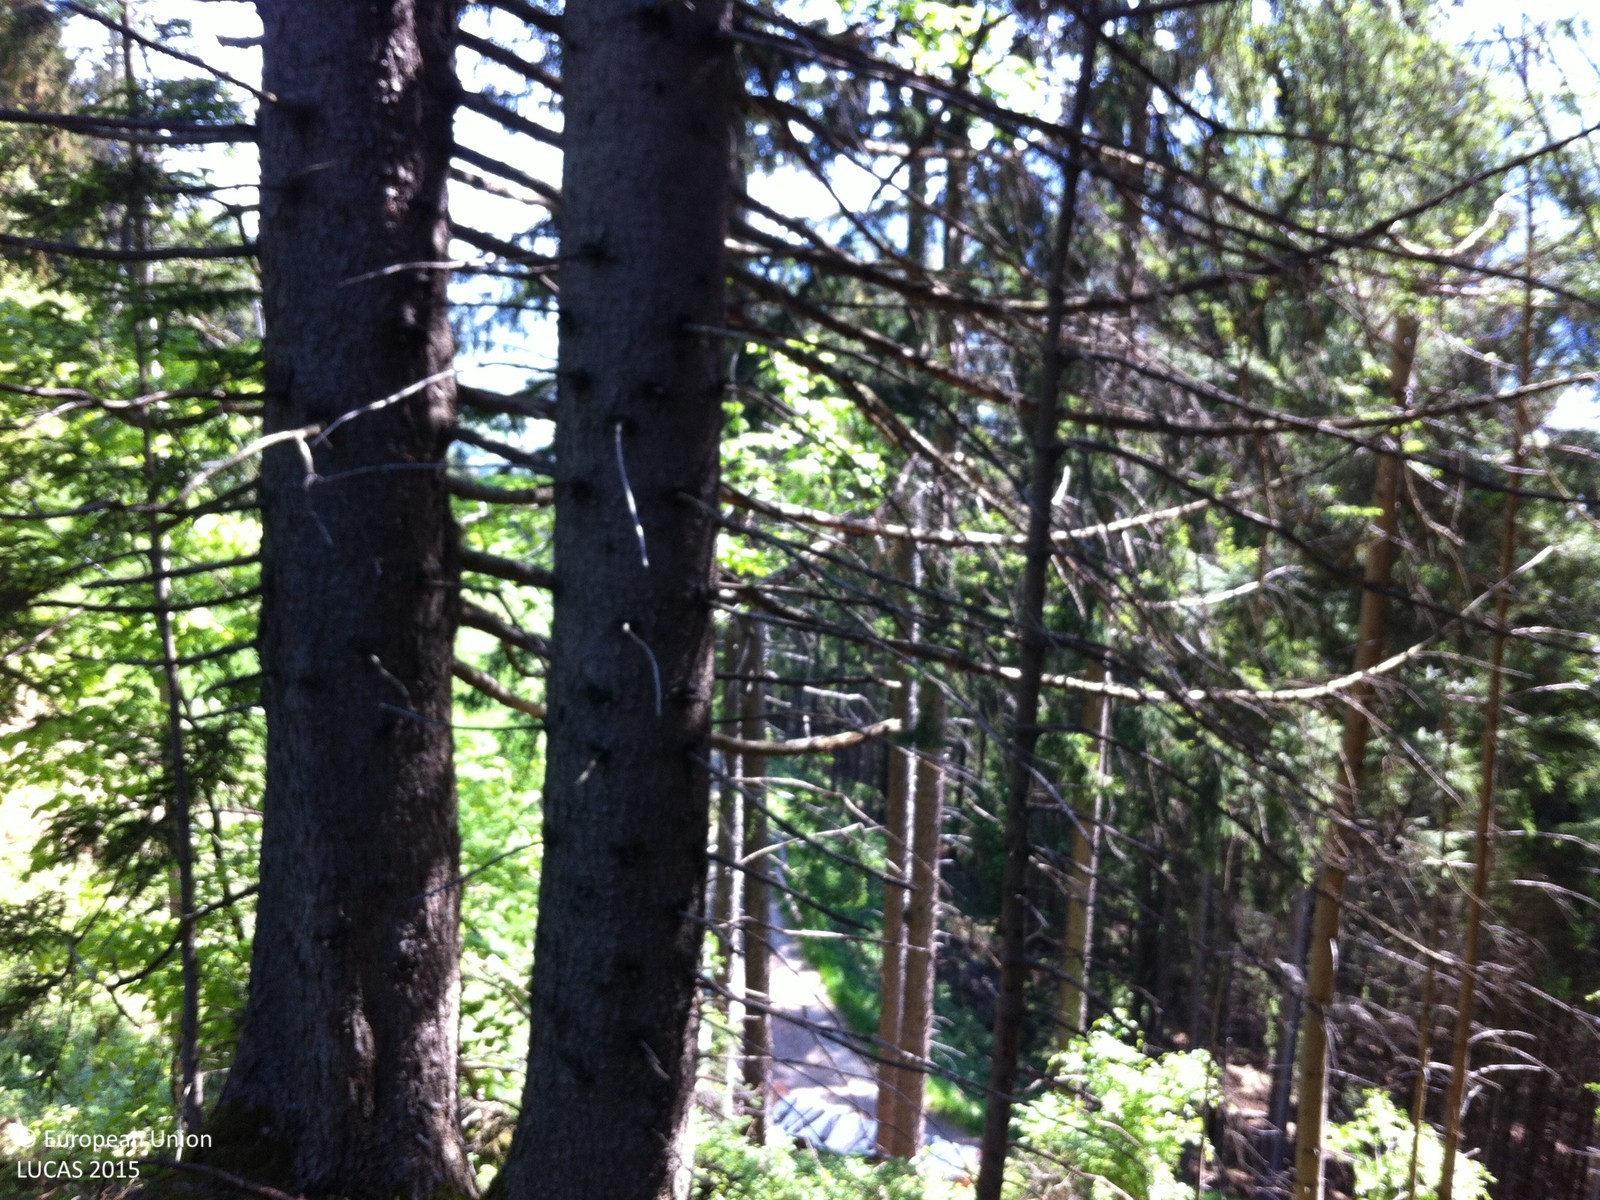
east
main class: Woodland
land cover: Spruce dominated coniferous woodland
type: alpine coniferous forest
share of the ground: > 75 %
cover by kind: coniferous forest trees 100 %
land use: Forestry
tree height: > 5 m
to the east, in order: Spruce dominated coniferous woodland; Tracks; Grass margins; Spruce dominated coniferous woodland; Shrubland with sparse tree cover; Tracks; Spruce dominated mixed woodland
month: May
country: AT
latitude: 47.3466
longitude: 11.6797
